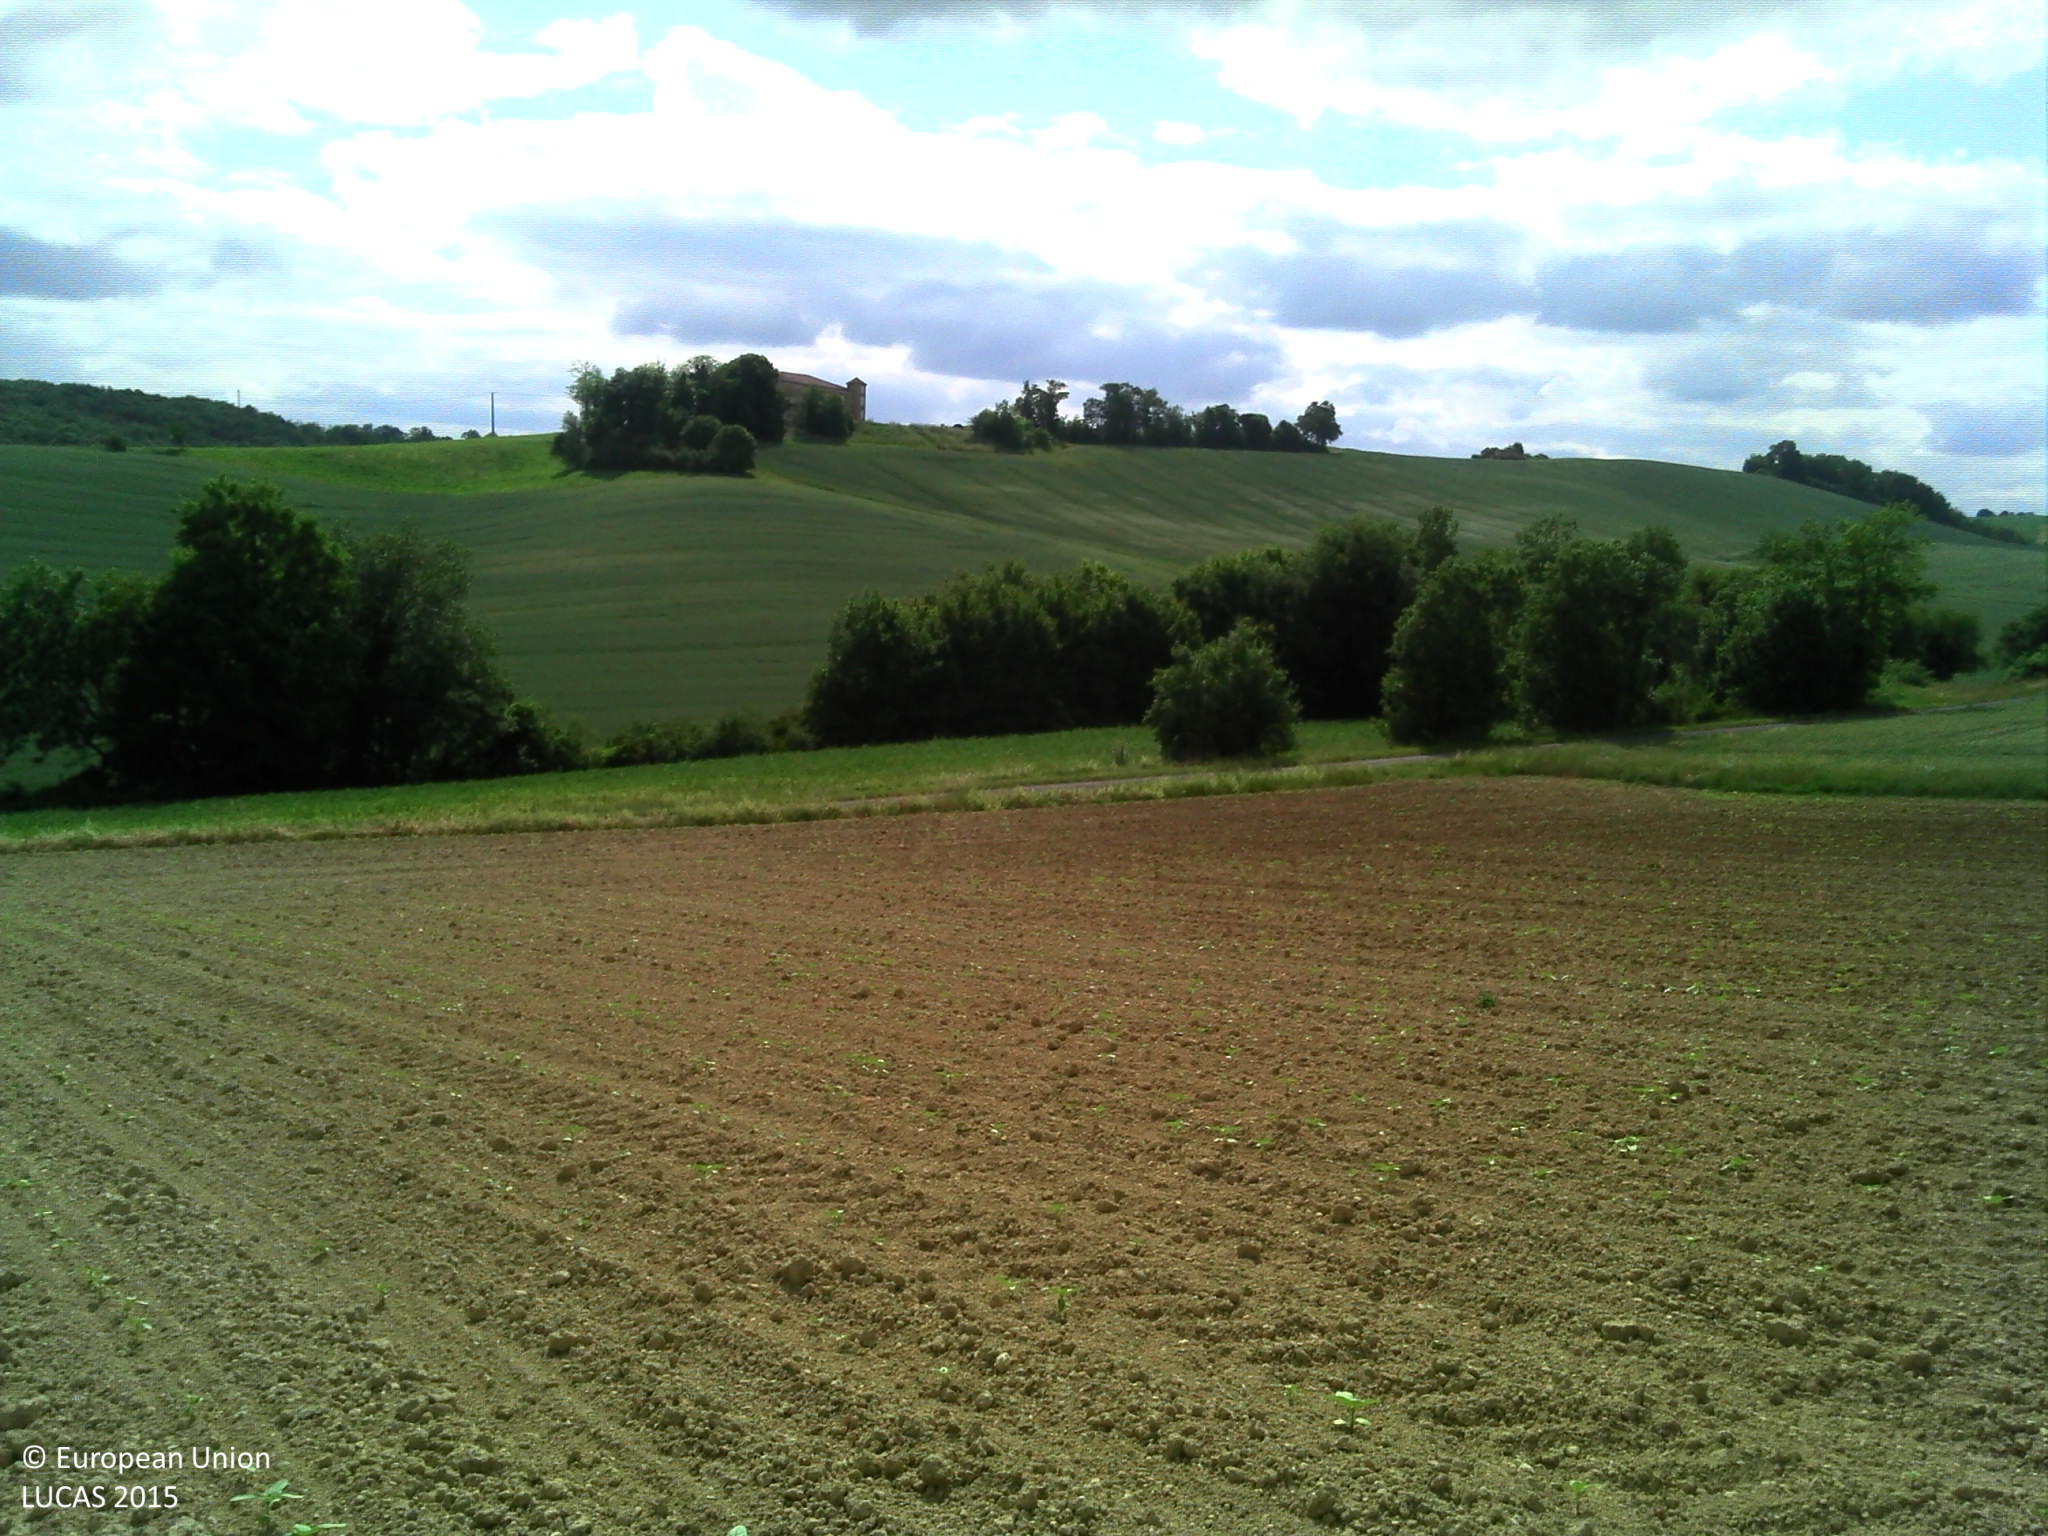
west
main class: Cropland
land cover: Sunflower
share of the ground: < 10 %
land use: Agriculture (excluding fallow land and kitchen gardens)
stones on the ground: < 10 %
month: June
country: FR
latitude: 43.5692
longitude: 0.7003
